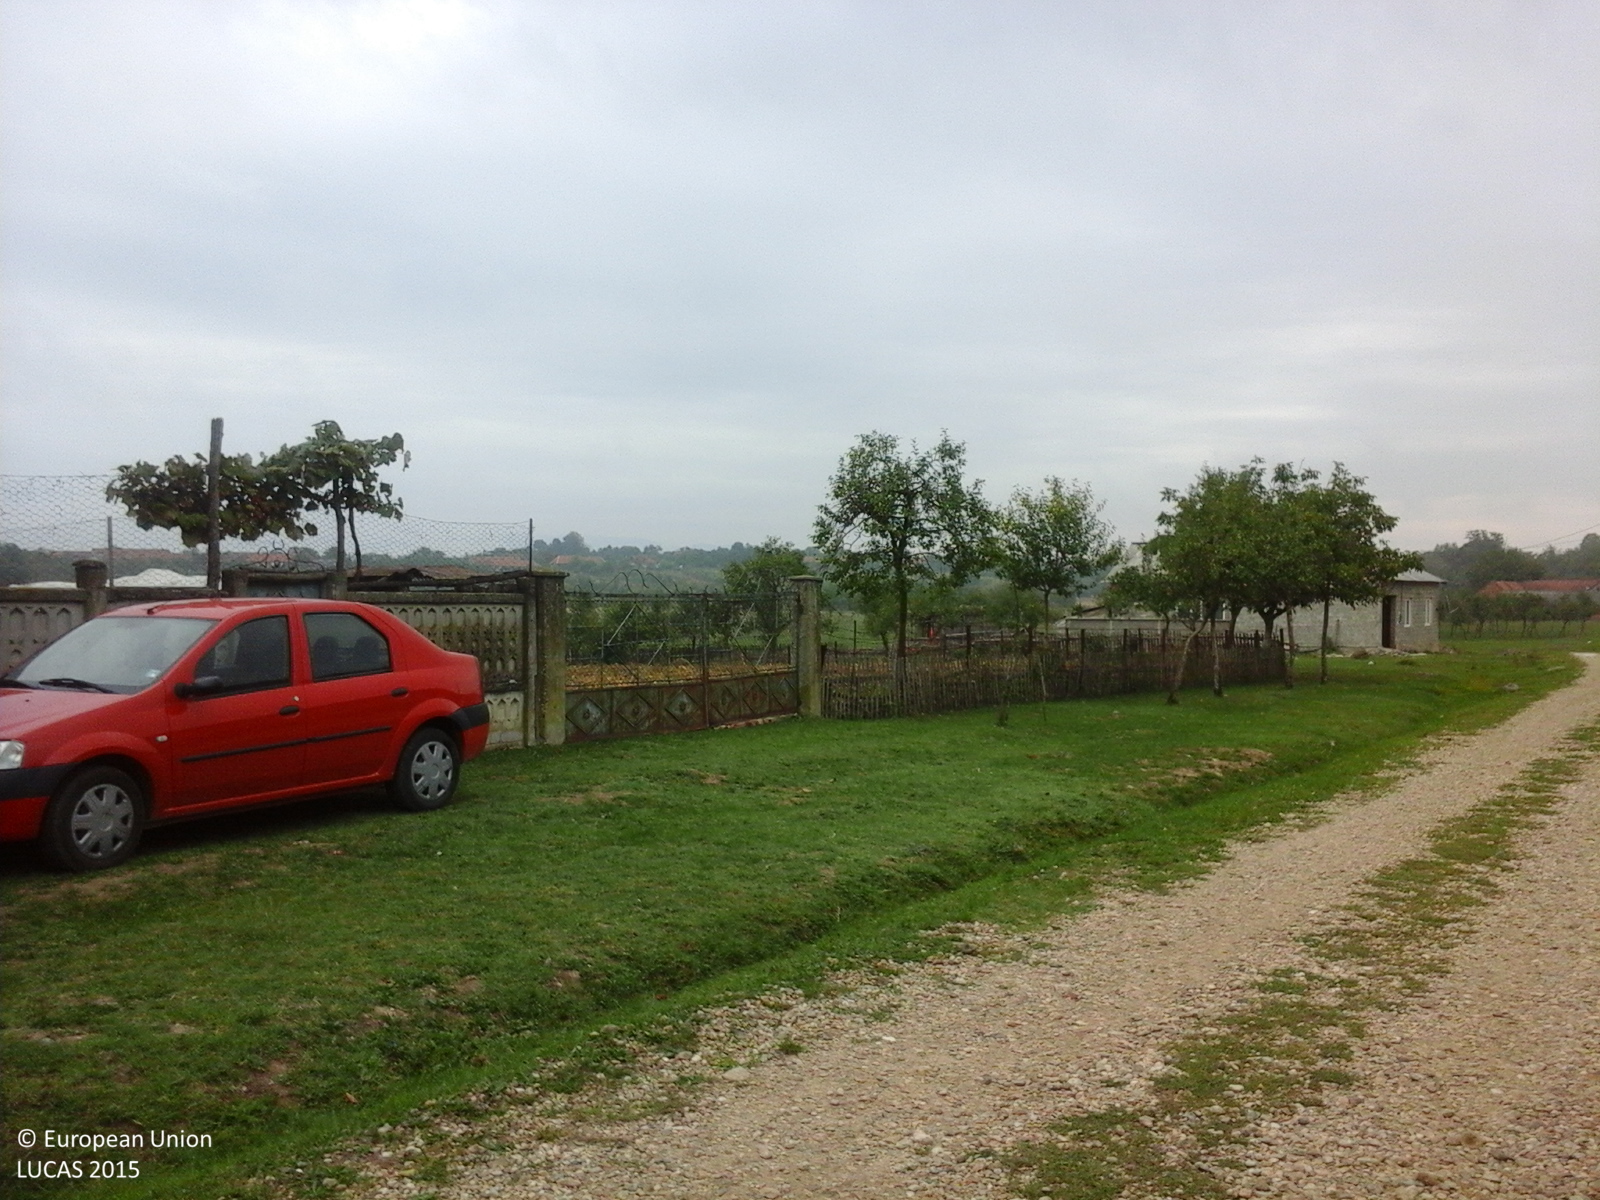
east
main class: Cropland
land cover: Apple fruit
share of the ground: > 75 %
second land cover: Grassland without tree/shrub cover
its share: > 75 %
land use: Agriculture (excluding fallow land and kitchen gardens)
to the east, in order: Apple fruit; Grassland without tree/shrub cover; Artificial constructions in urban areas; Grassland without tree/shrub cover
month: September
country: RO
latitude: 45.6058
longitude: 21.9498
